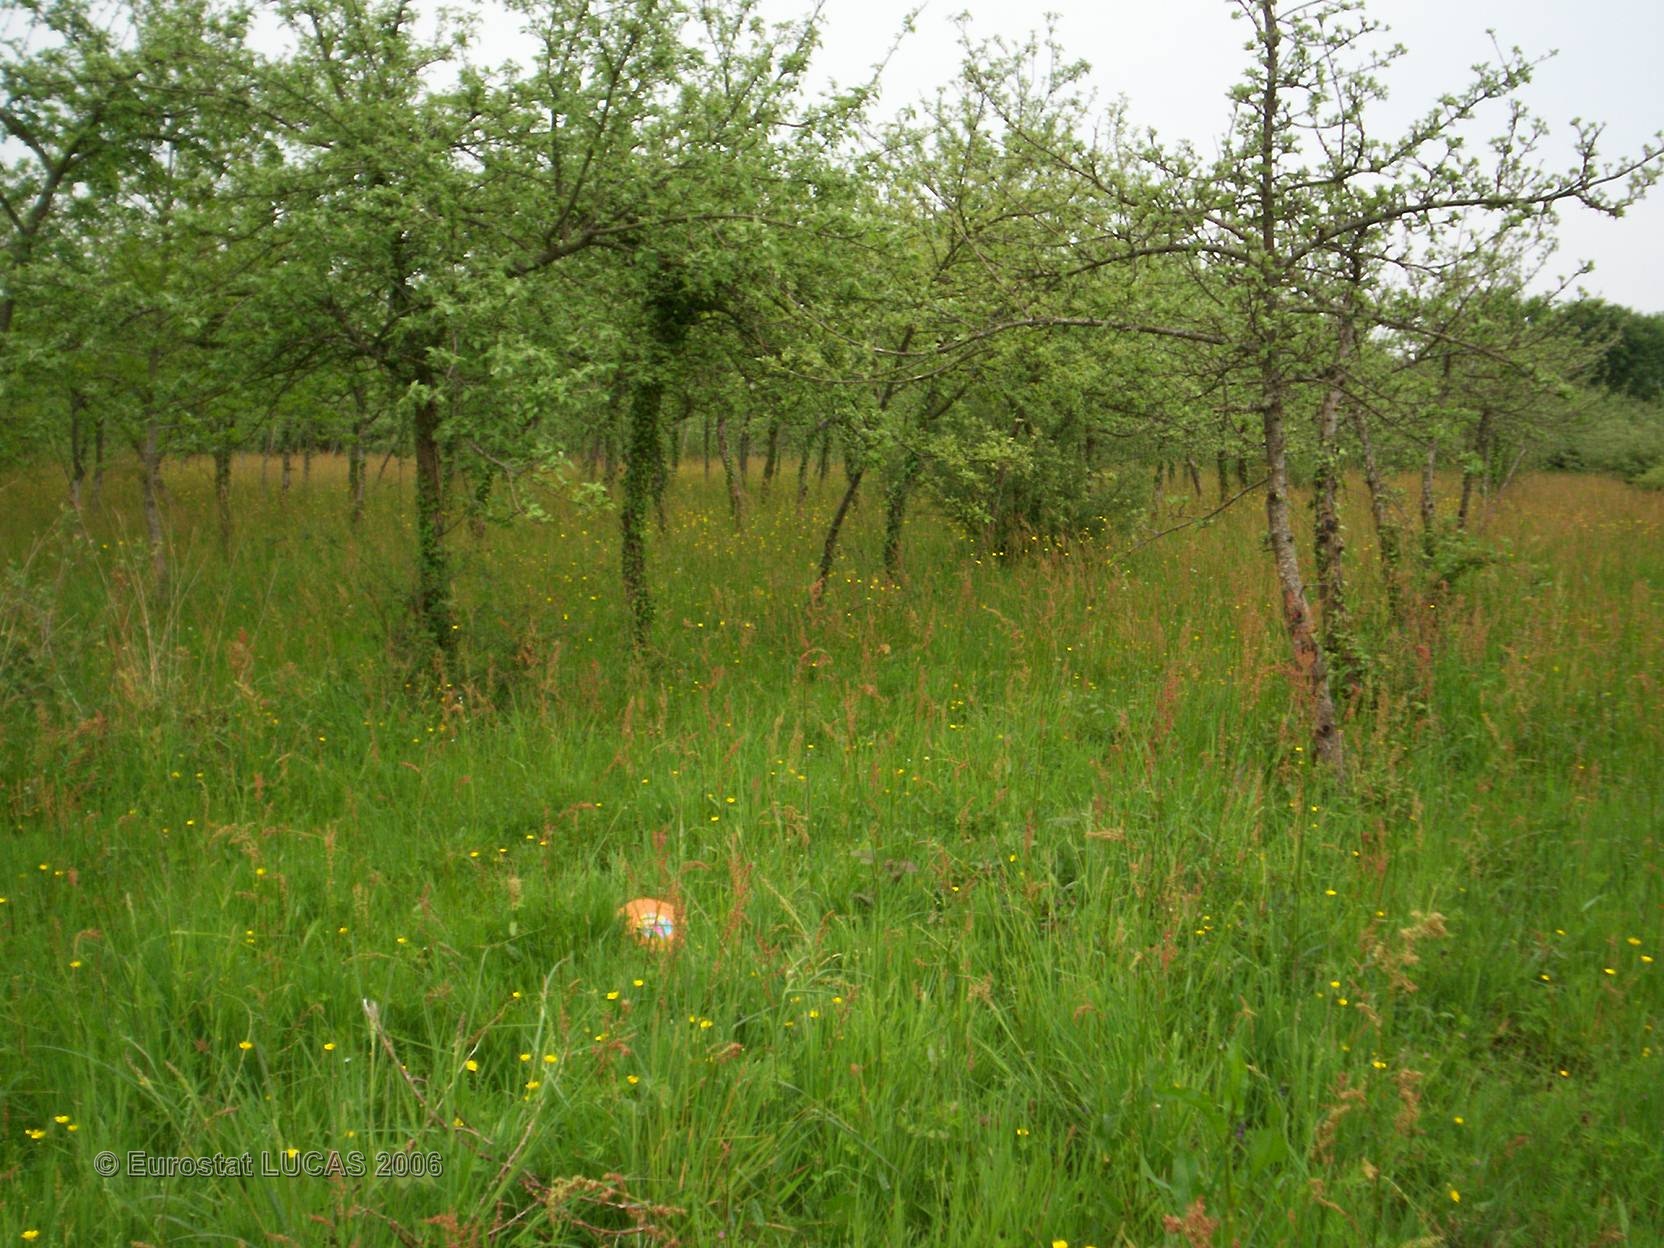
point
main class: Cropland
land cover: Apple fruit
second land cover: Grassland with sparse tree/shrub cover
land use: Agriculture (excluding fallow land and kitchen gardens)
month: May
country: FR
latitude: 48.3116
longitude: -1.6581
